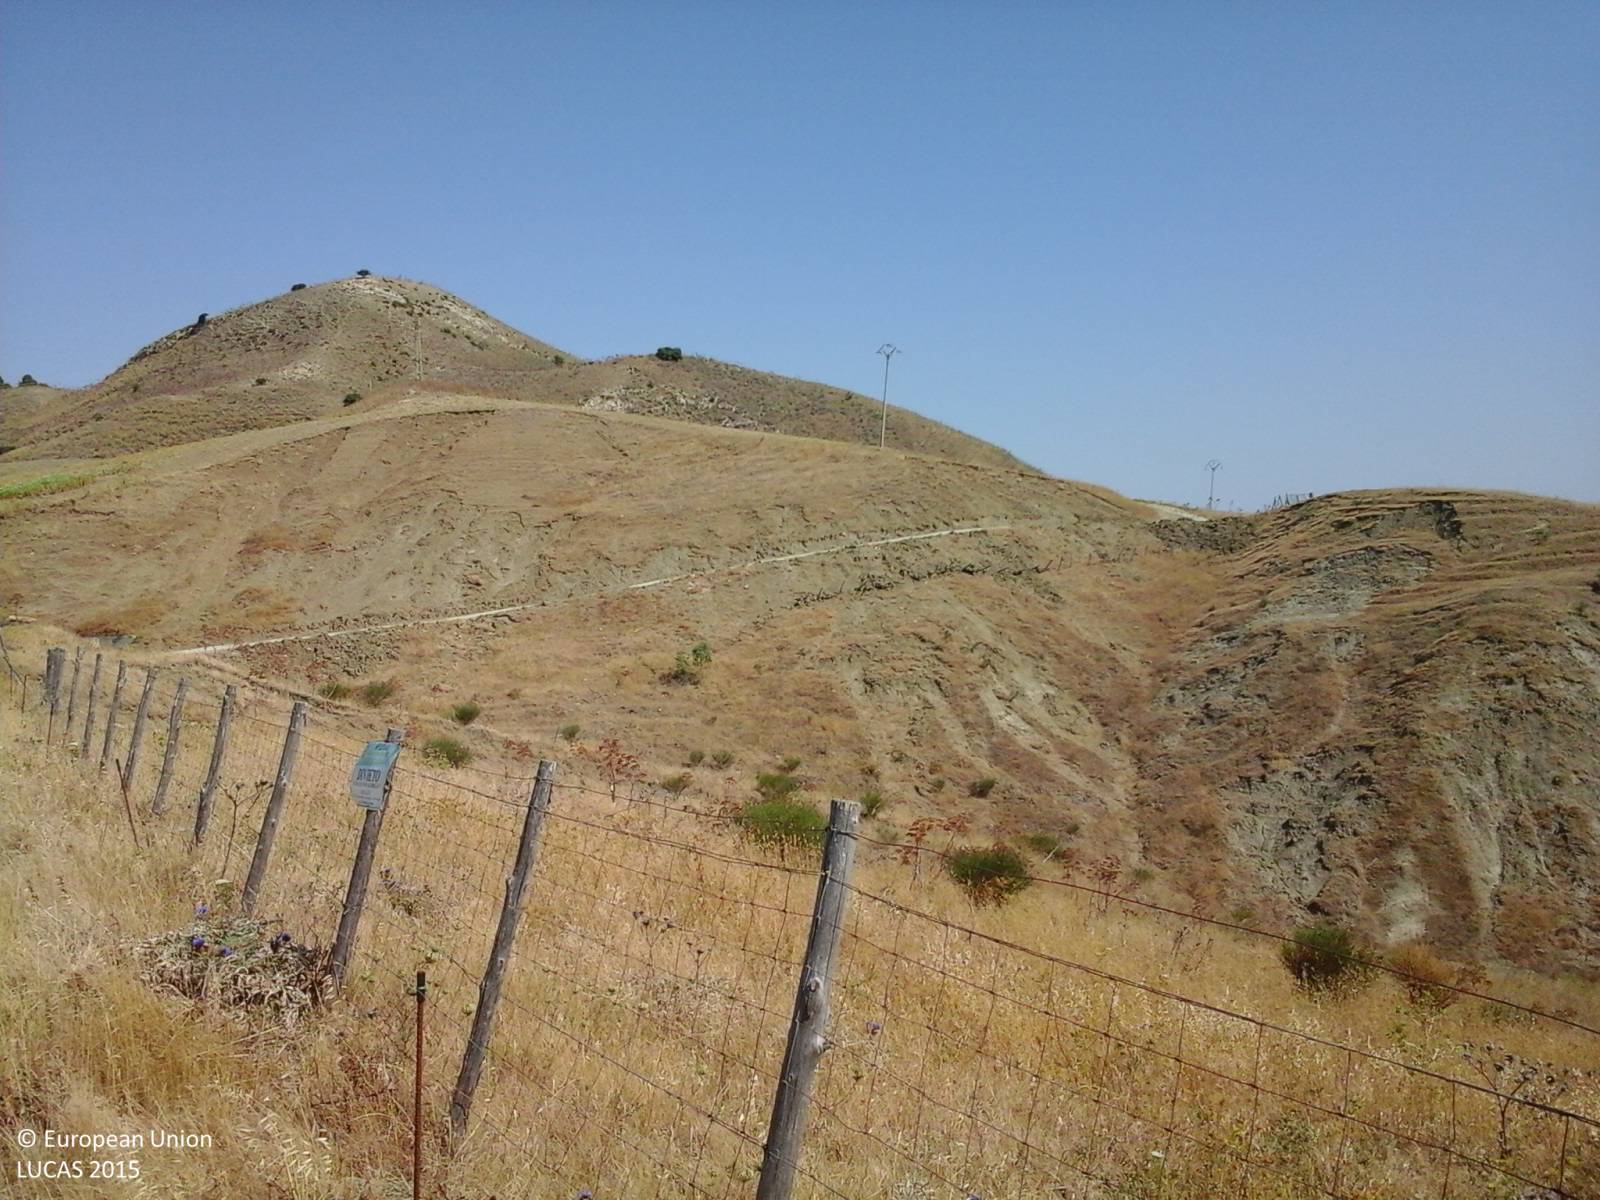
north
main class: Grassland
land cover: Grassland without tree/shrub cover
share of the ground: > 75 %
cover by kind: herbaceous plants 100 %
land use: Semi-natural and natural areas not in use
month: July
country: IT
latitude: 37.7864
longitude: 13.1449
